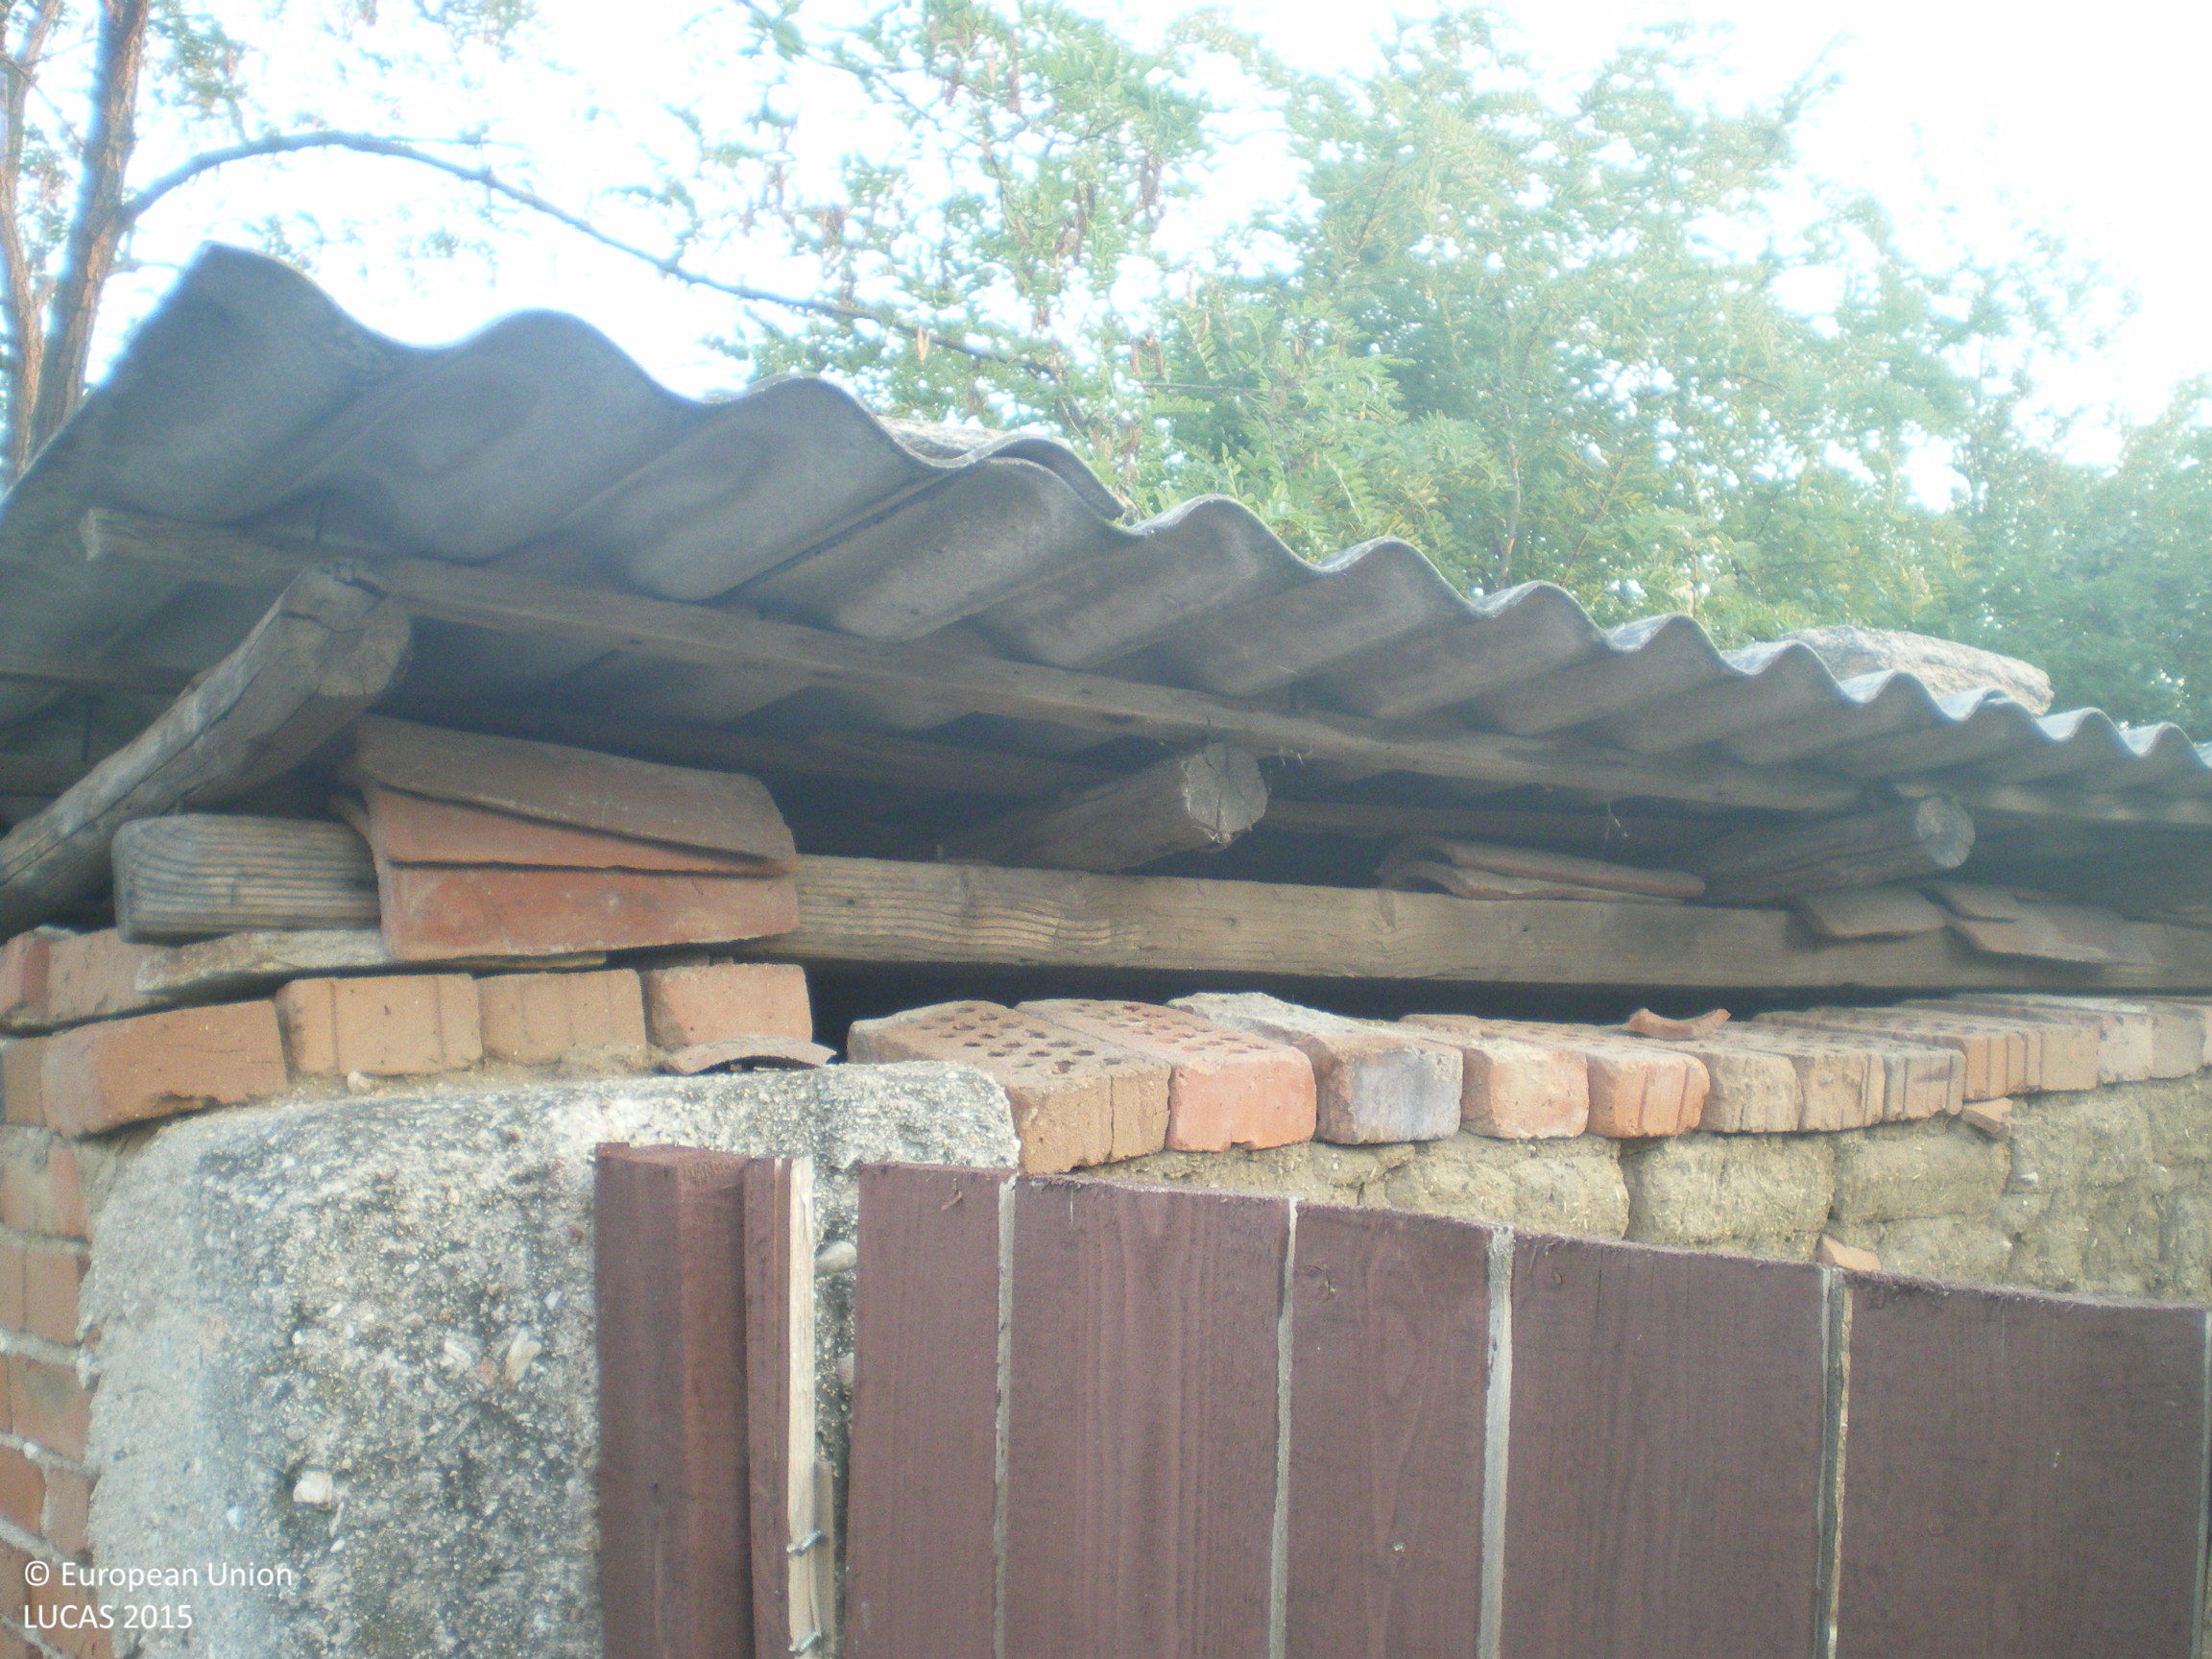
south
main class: Grassland
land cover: Grassland with sparse tree/shrub cover
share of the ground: > 75 %
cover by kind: herbaceous plants 85 %, shrubs 10 %, broadleaved forest trees 5 %
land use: Residential
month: August
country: BG
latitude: 41.9713
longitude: 25.8181
